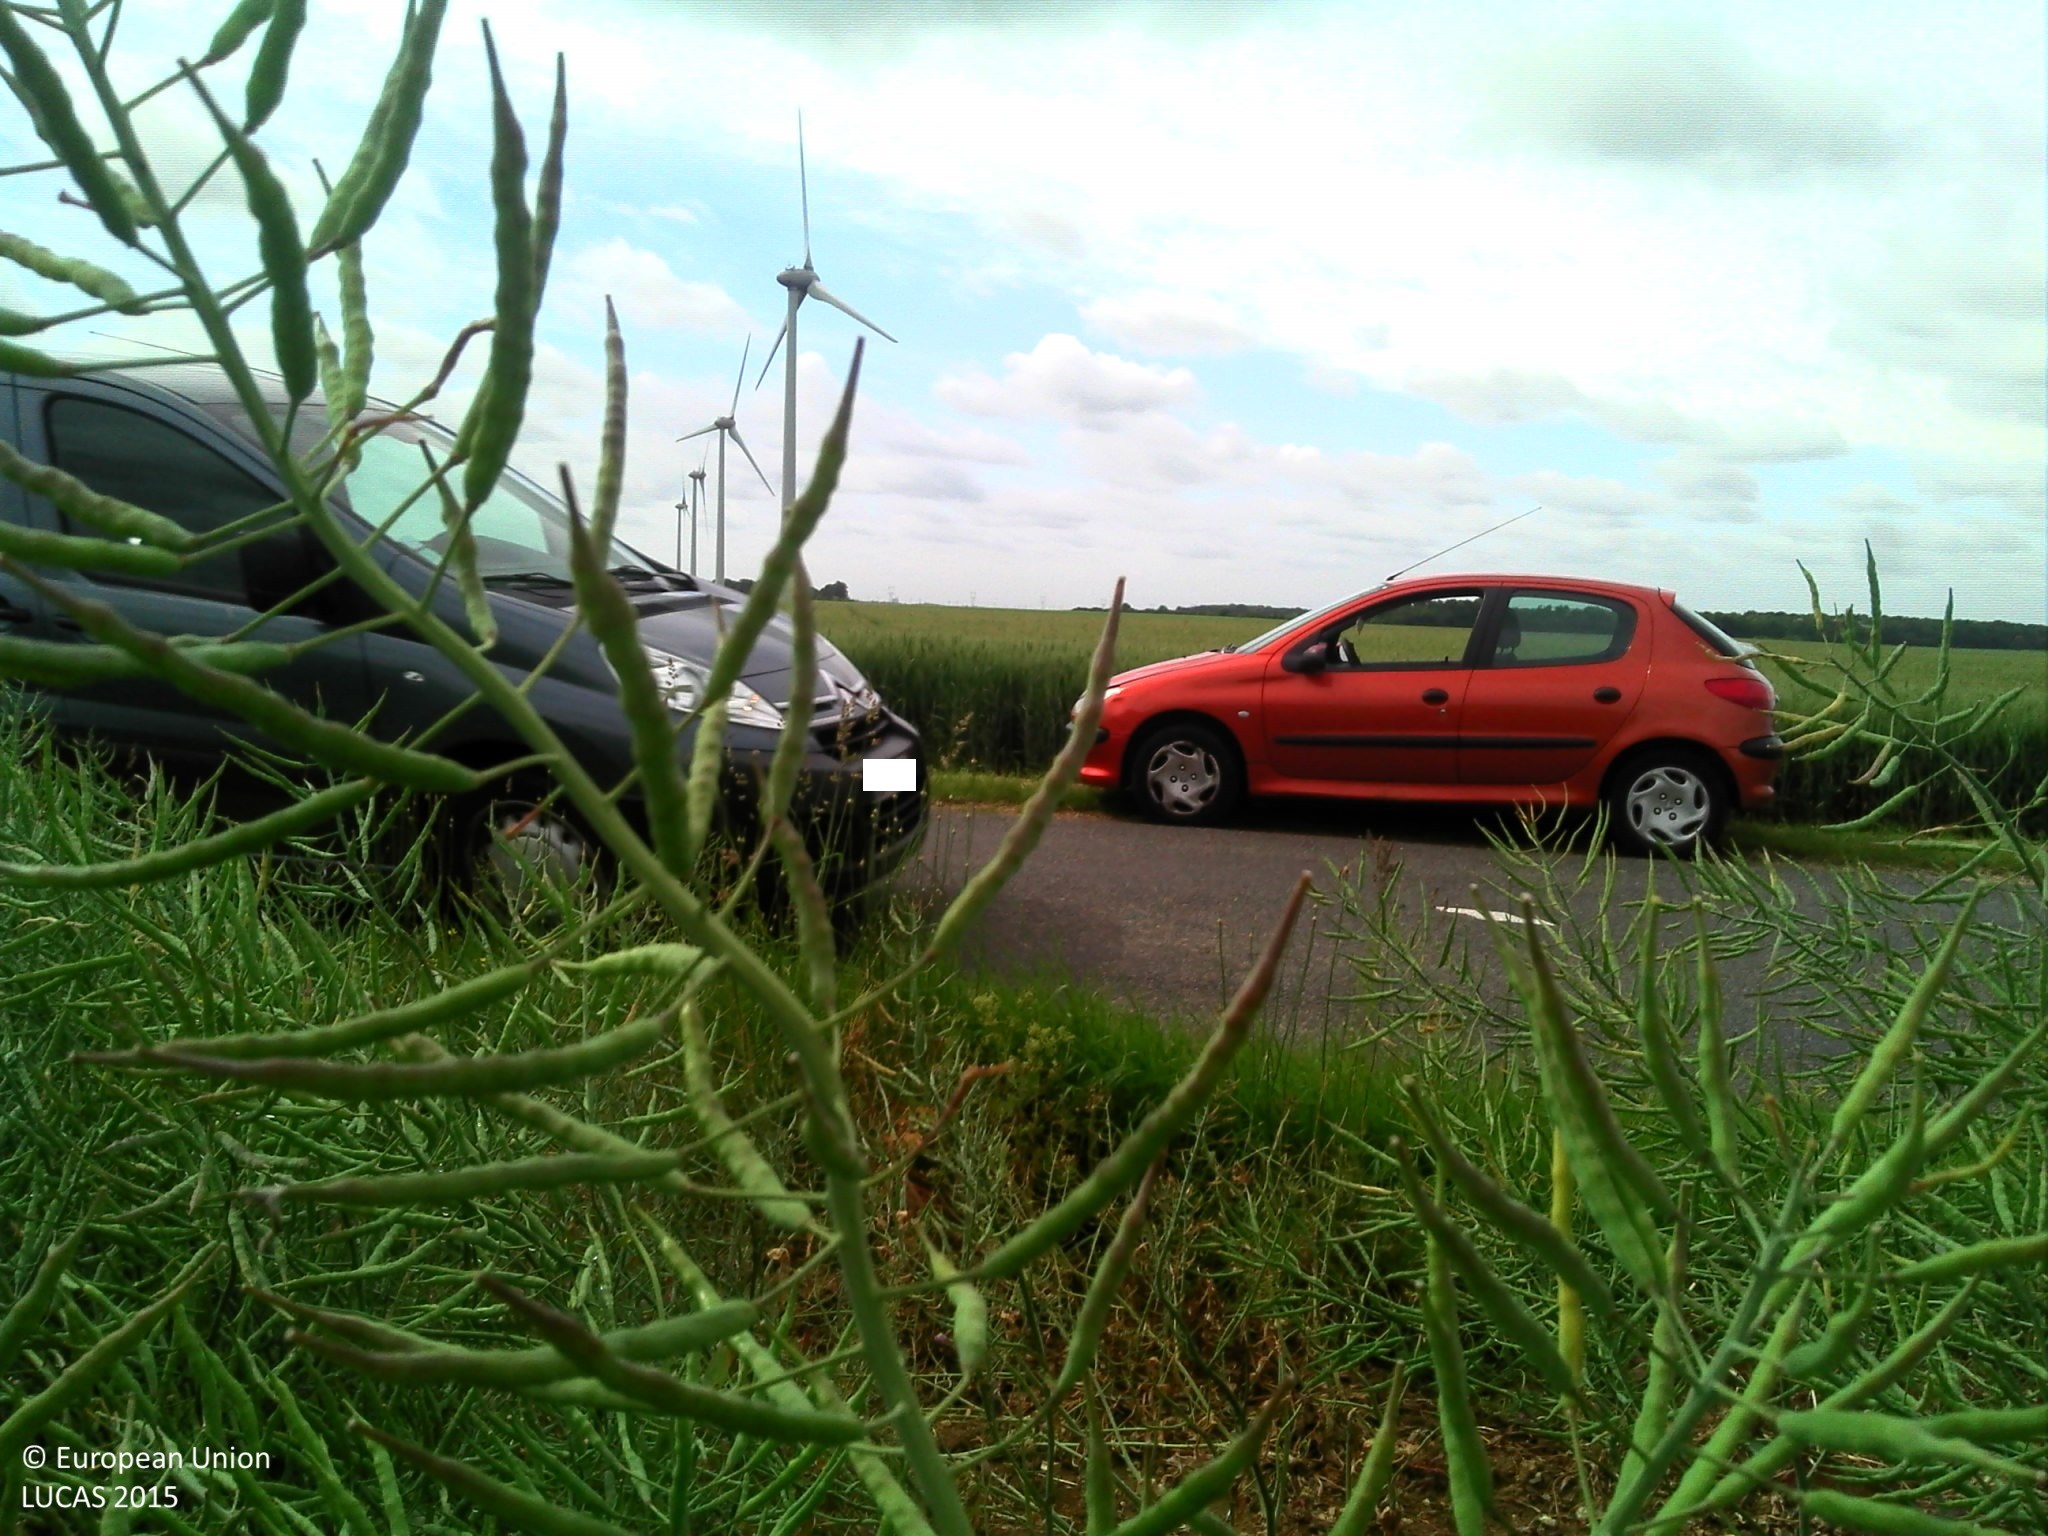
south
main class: Cropland
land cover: Rape and turnip rape
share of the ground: > 75 %
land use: Agriculture (excluding fallow land and kitchen gardens)
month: June
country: FR
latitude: 48.3453
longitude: 1.9584
